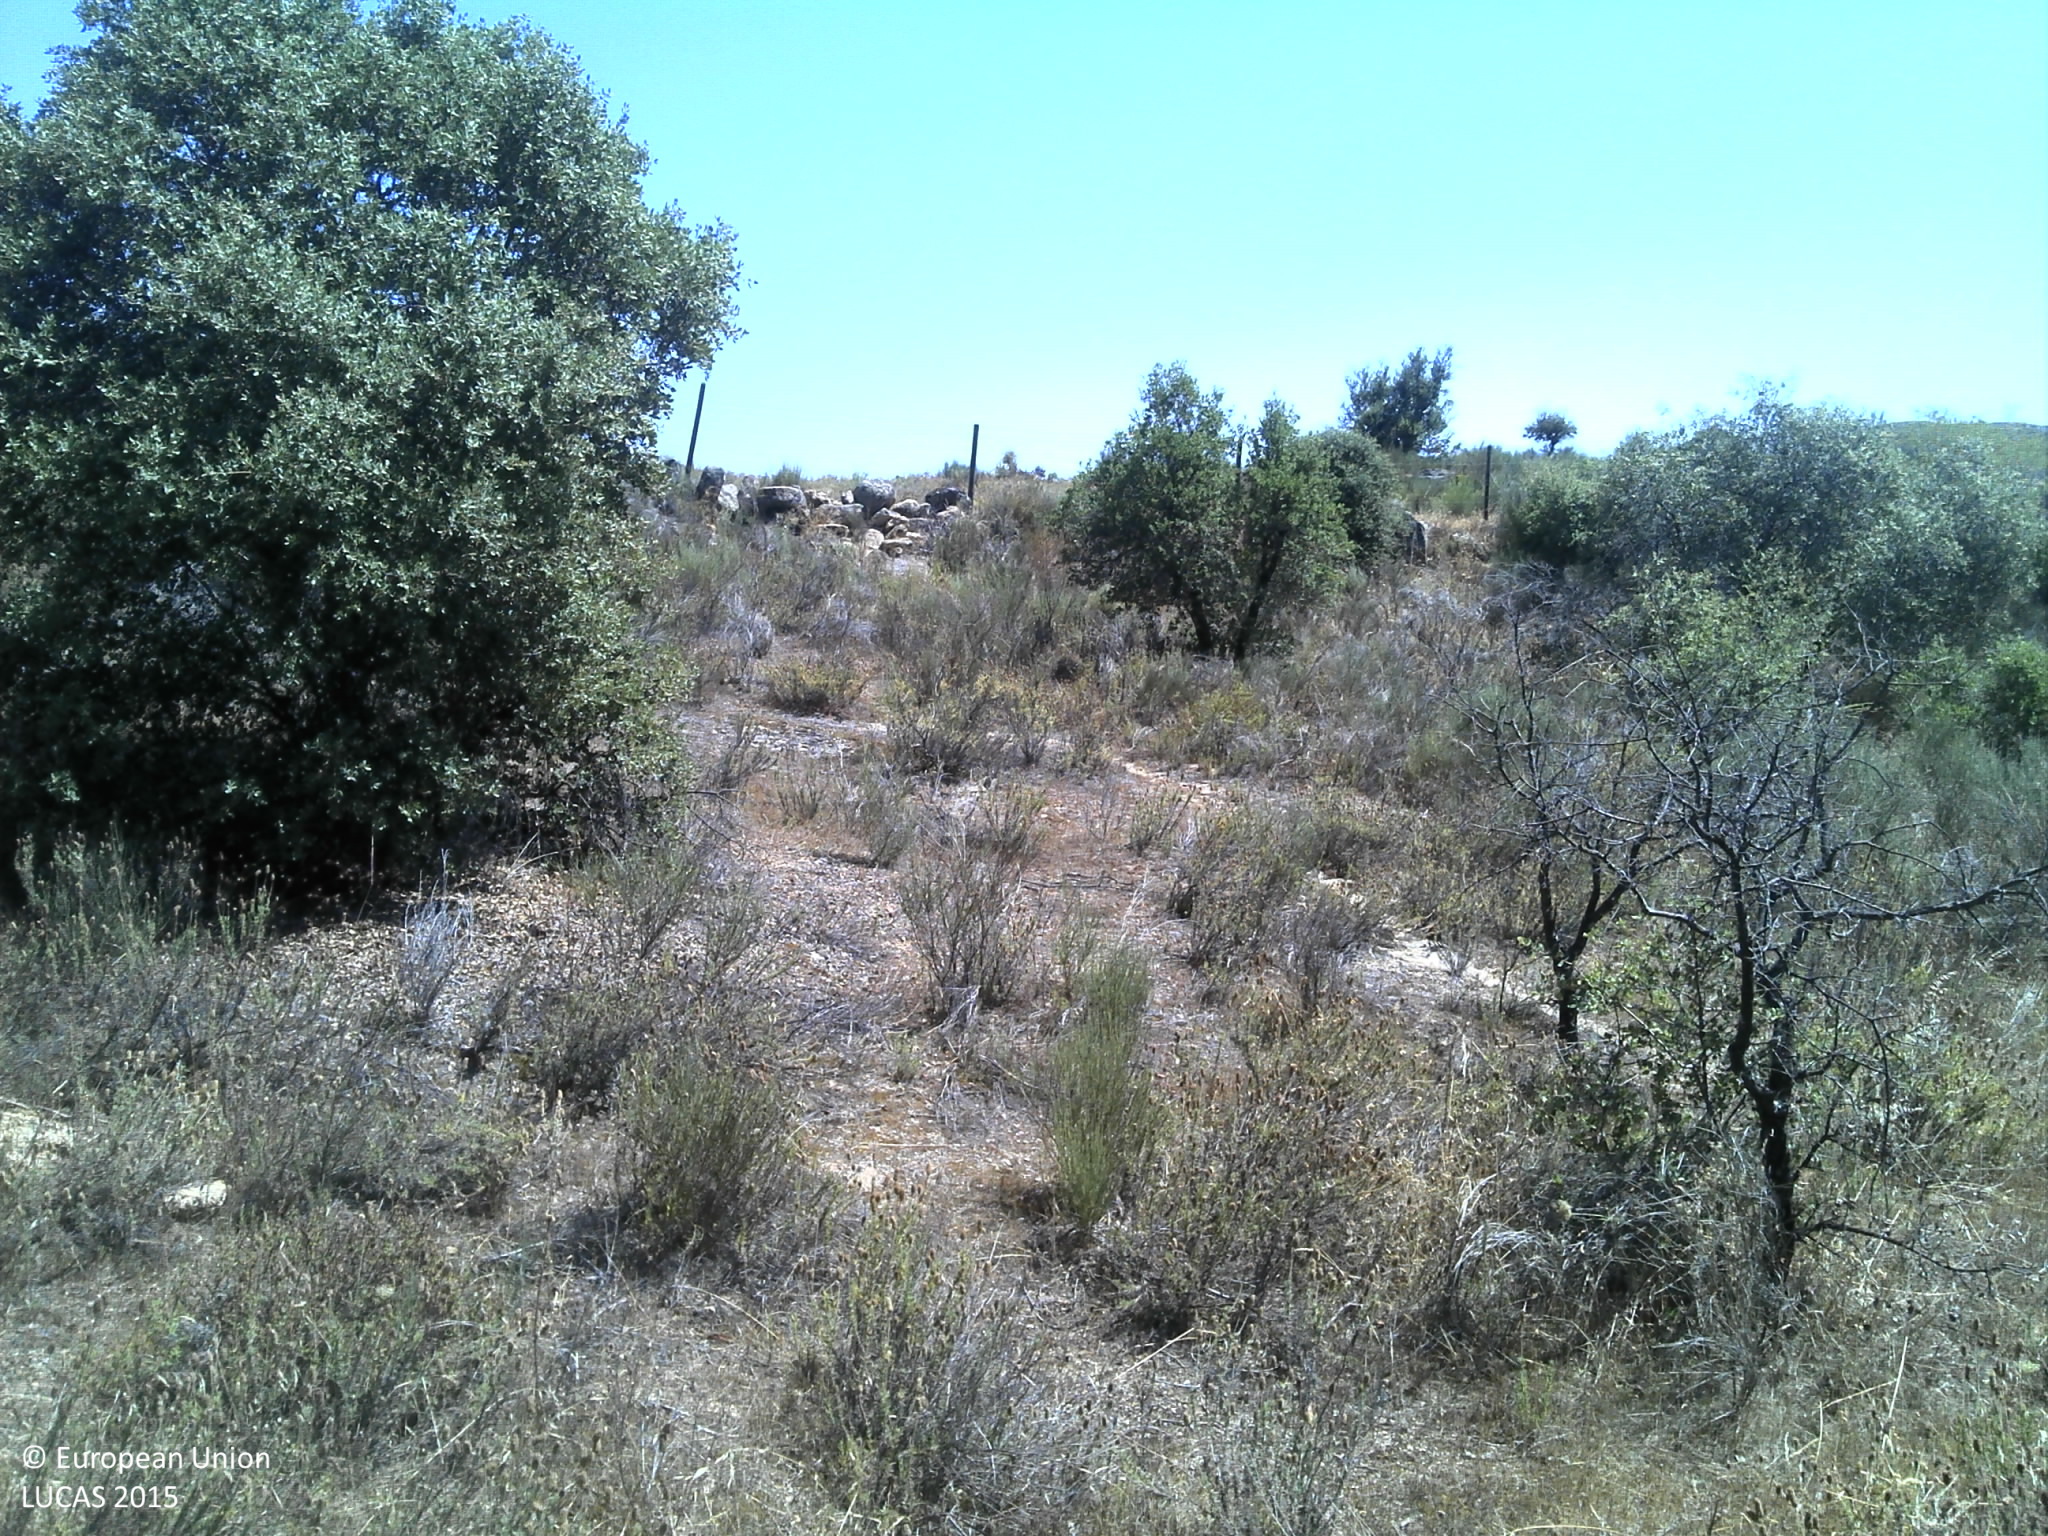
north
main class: Woodland
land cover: Broadleaved woodland
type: exotic forest
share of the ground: 25 - 50 %
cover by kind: broadleaved forest trees 50 %, shrubs 20 %, unconsolidated bare surface 15 %, herbaceous plants 10 %
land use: Forestry
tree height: > 5 m
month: June
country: PT
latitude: 40.0469
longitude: -7.2933
